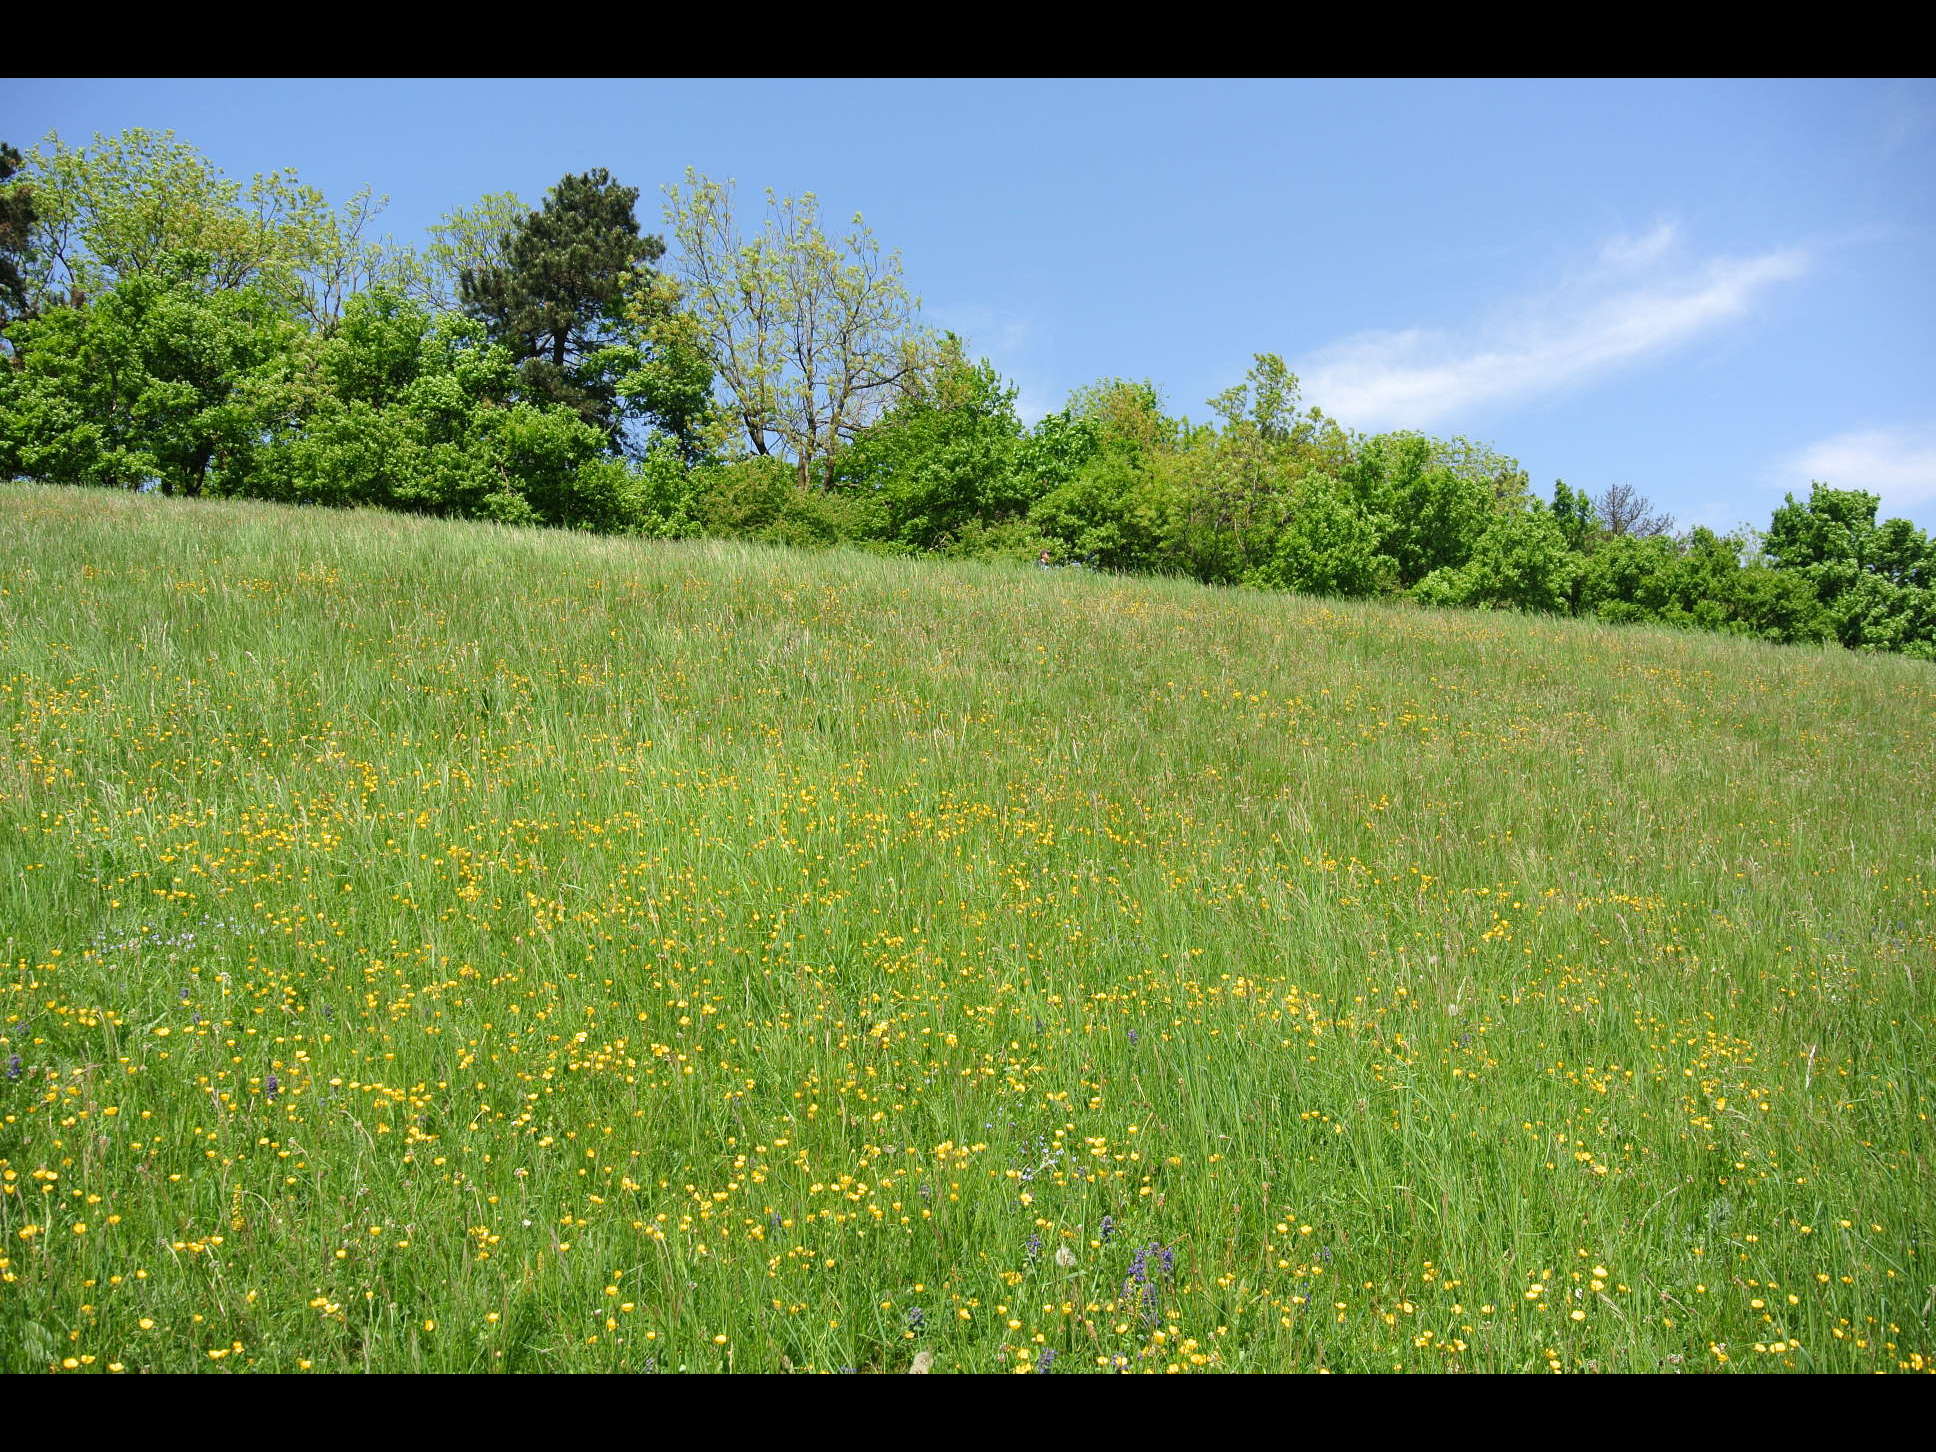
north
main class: Grassland
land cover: Grassland without tree/shrub cover
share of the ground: > 75 %
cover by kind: herbaceous plants 100 %
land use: Agriculture (excluding fallow land and kitchen gardens)
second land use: Amenities, museums, leisure
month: May
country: AT
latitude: 48.1019
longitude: 16.2219
